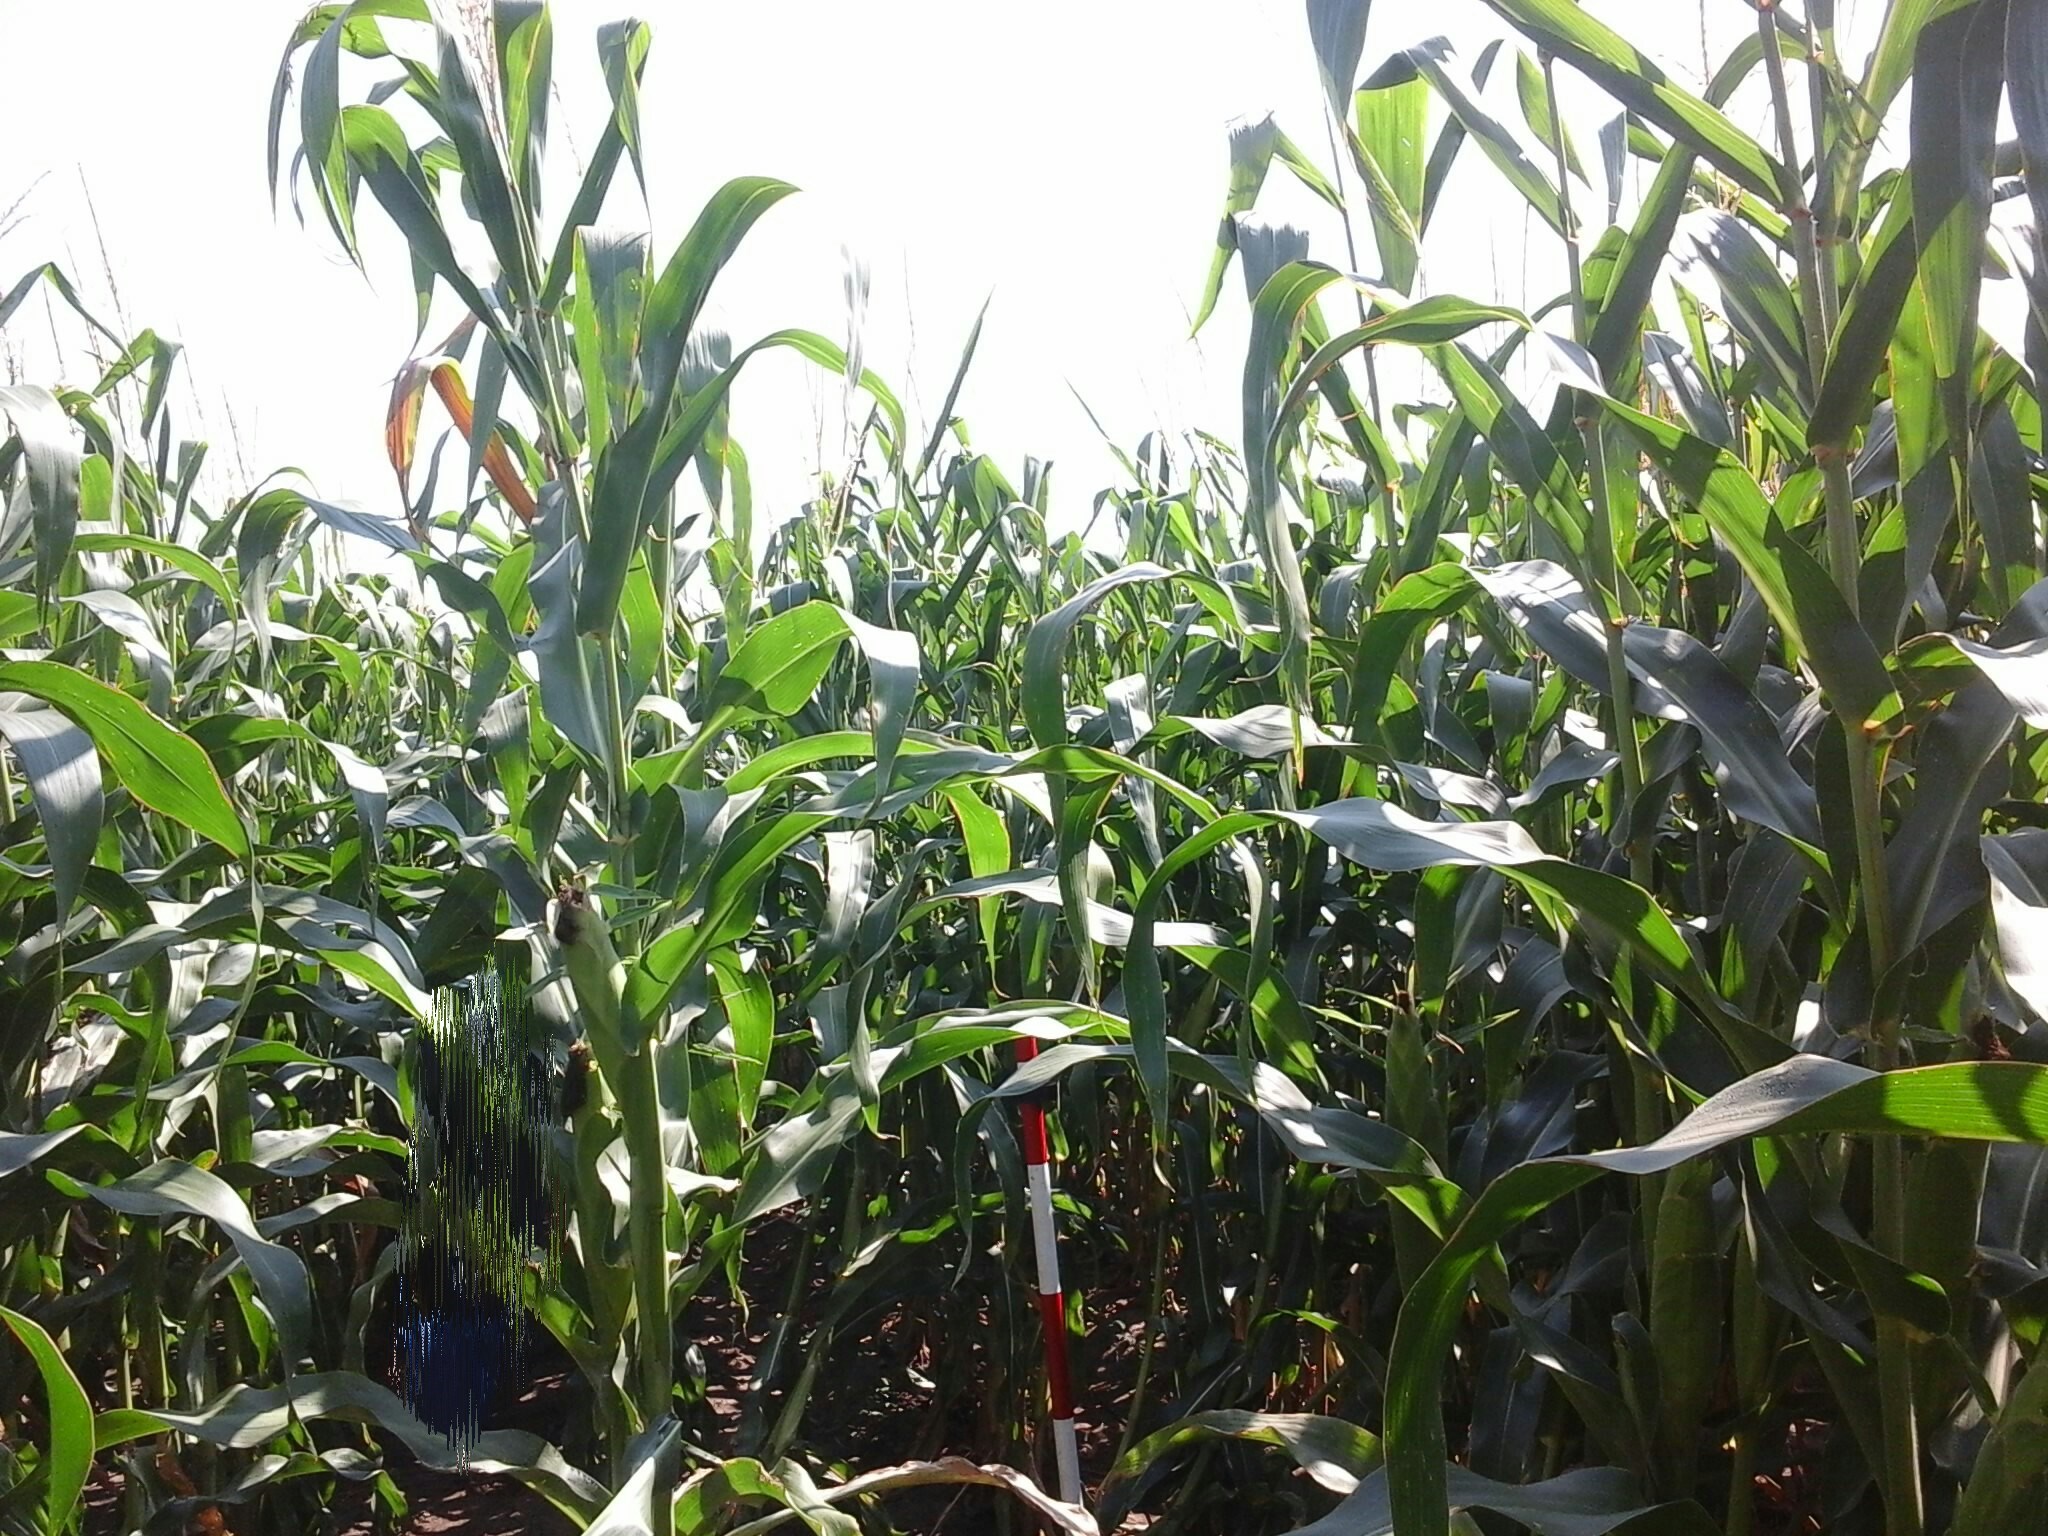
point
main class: Cropland
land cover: Maize
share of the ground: > 75 %
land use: Agriculture (excluding fallow land and kitchen gardens)
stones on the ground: < 10 %
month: August
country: HU
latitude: 47.1320
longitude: 18.3038
